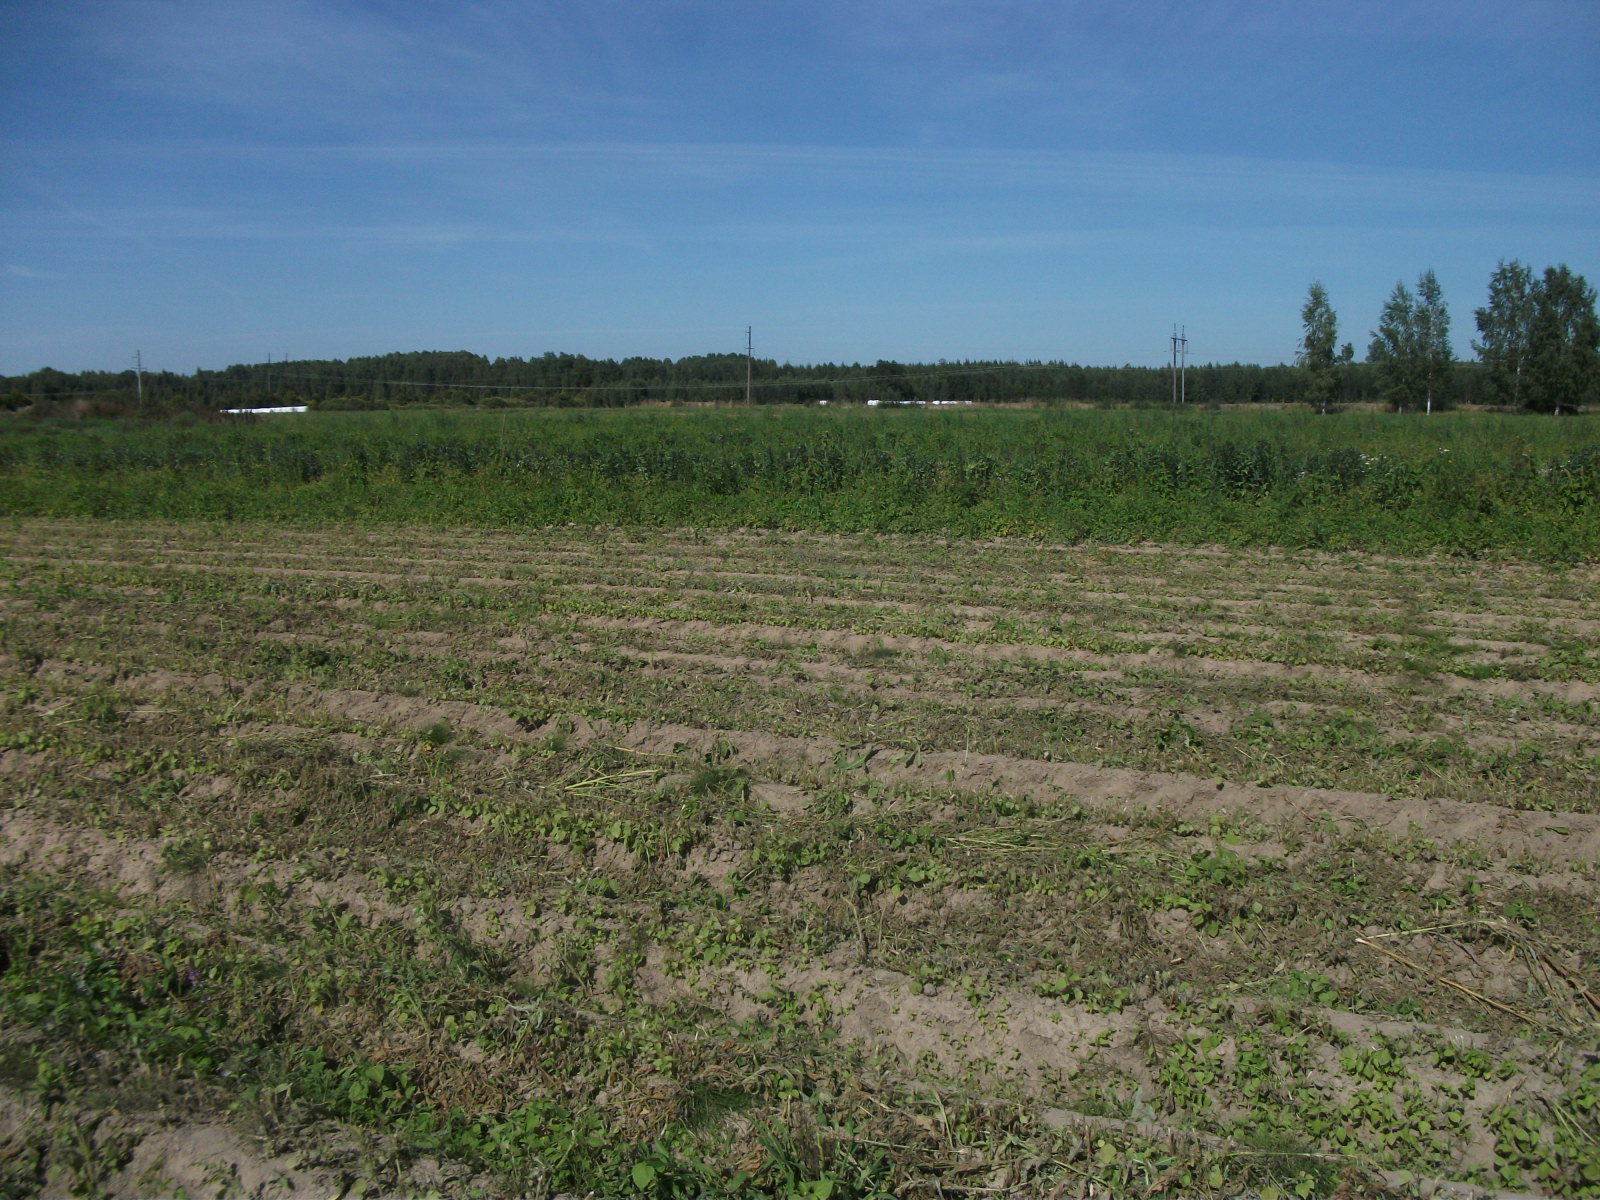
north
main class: Cropland
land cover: Potatoes
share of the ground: < 10 %
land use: Agriculture (excluding fallow land and kitchen gardens)
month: August
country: LV
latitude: 56.2043
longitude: 26.2789
